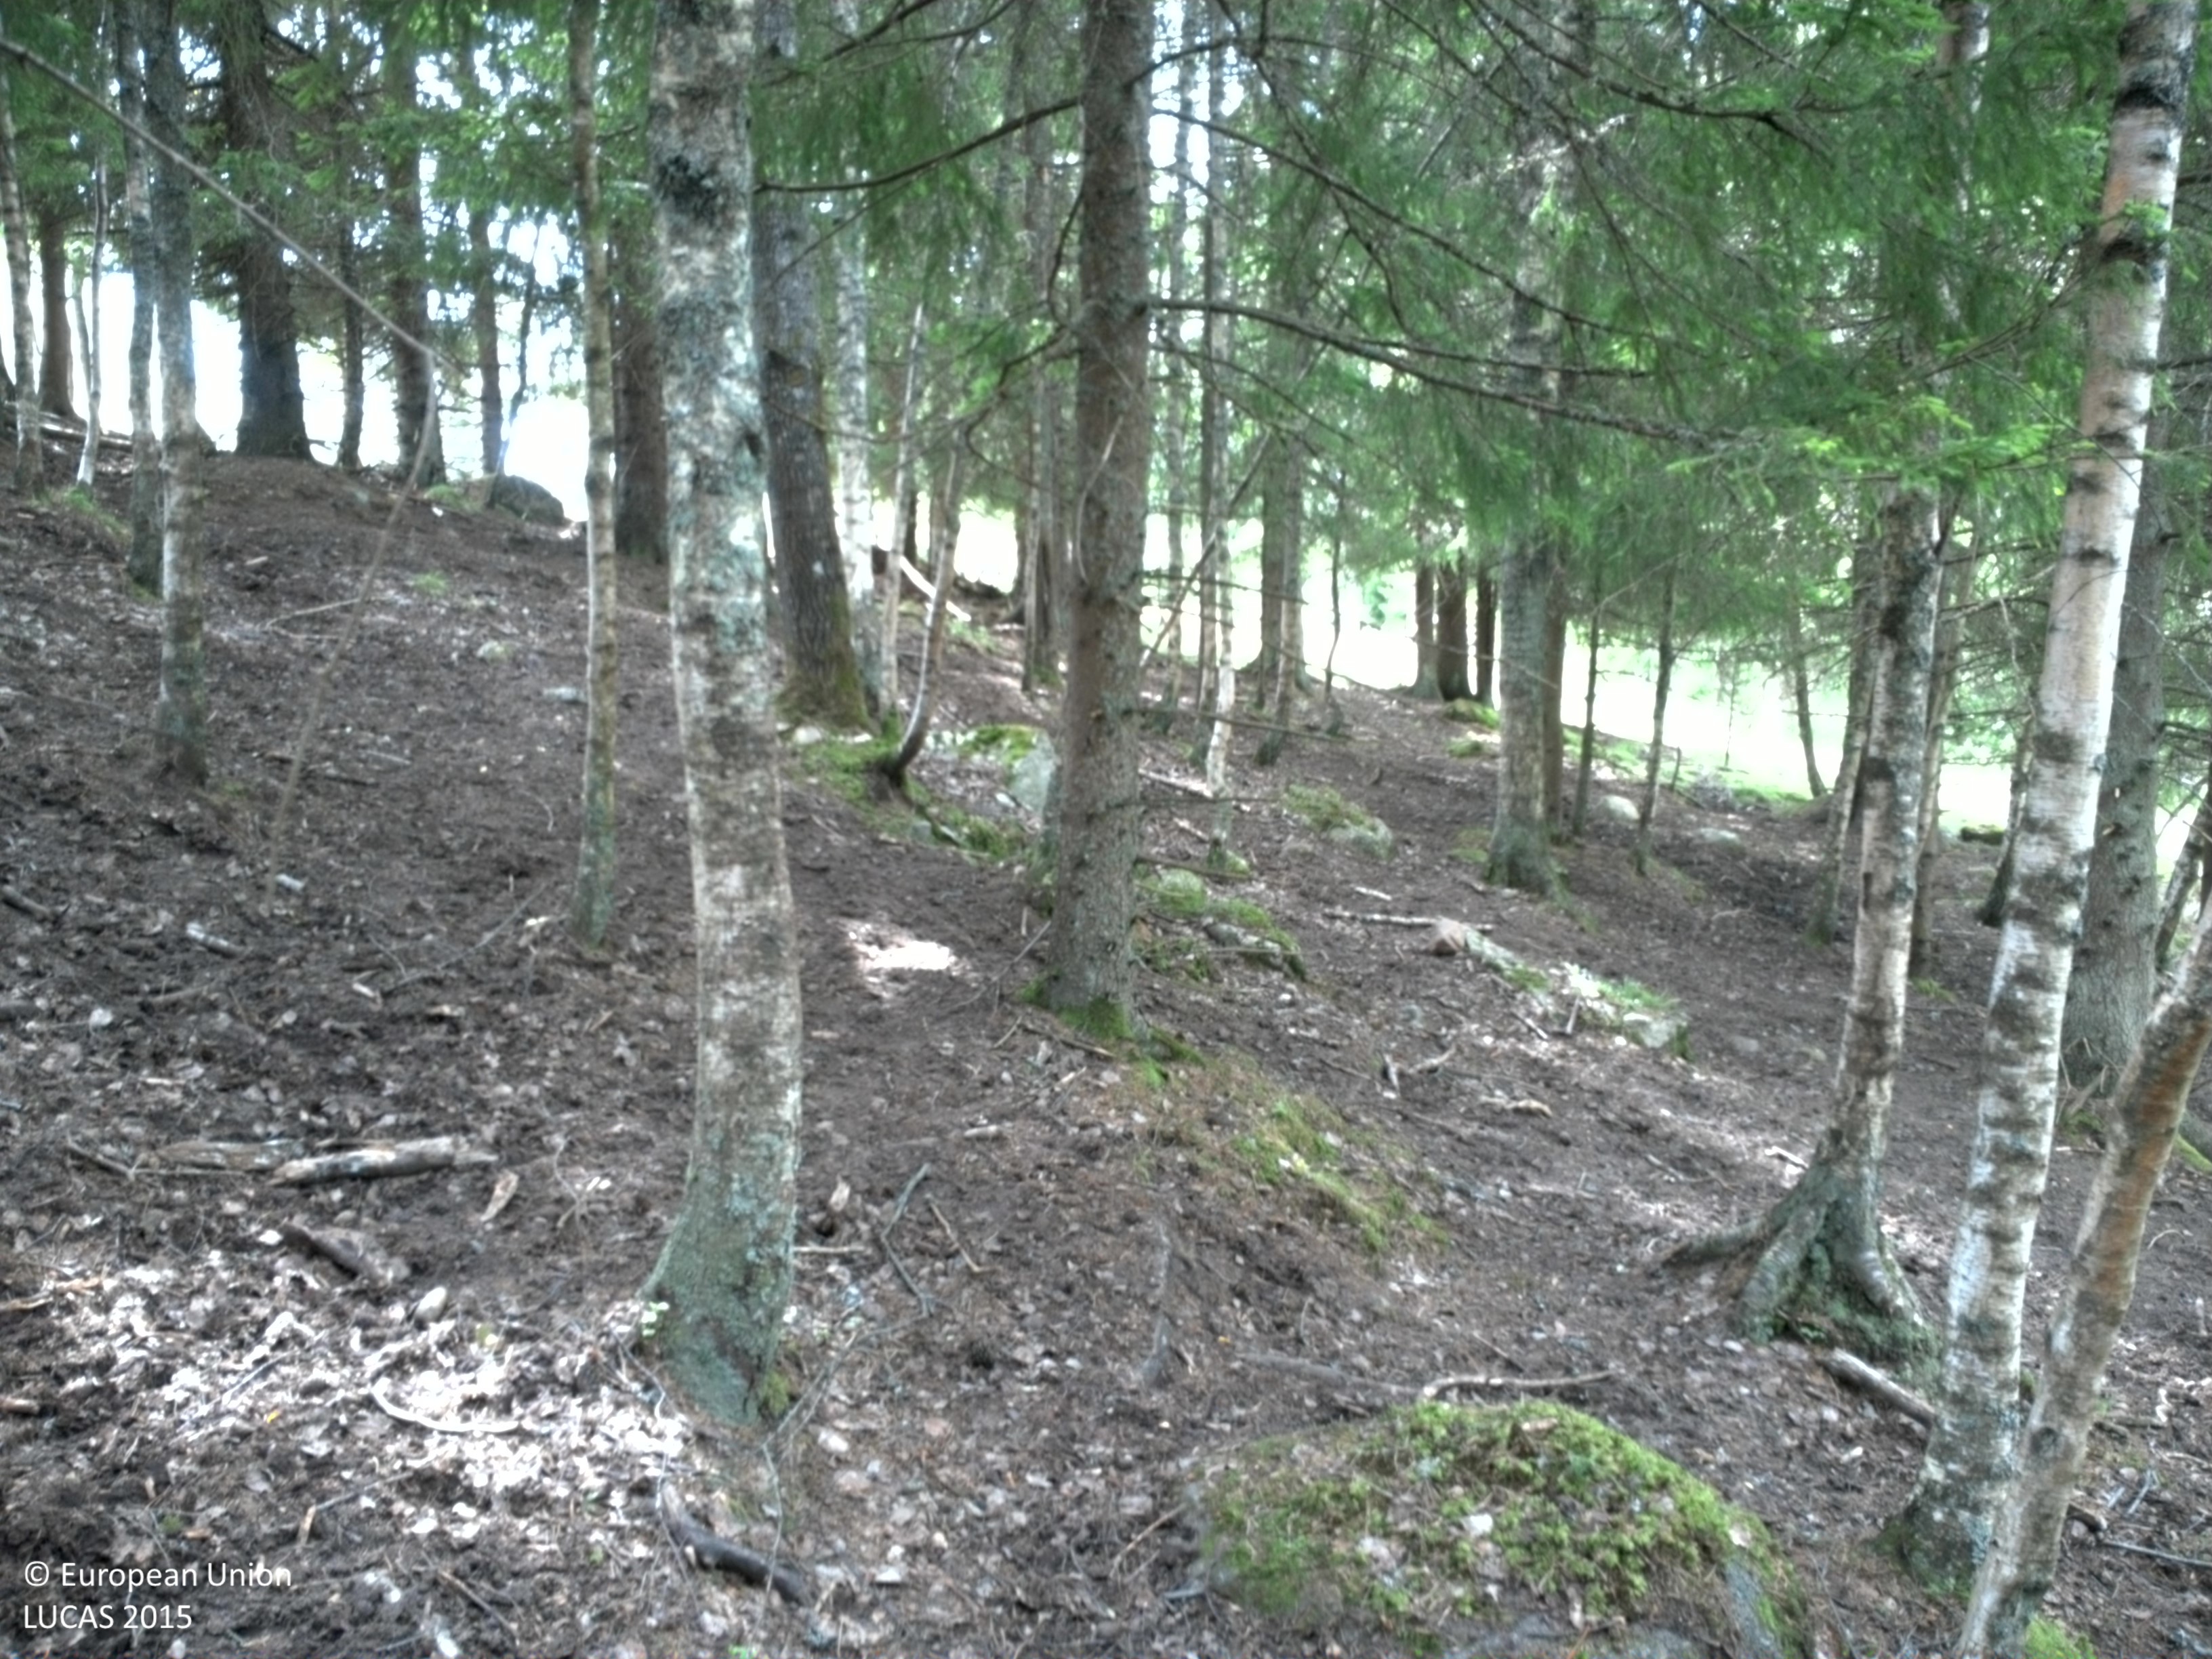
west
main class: Woodland
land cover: Spruce dominated coniferous woodland
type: boreal forest
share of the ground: > 75 %
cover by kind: coniferous forest trees 80 %, broadleaved forest trees 10 %, lichens and mosses 10 %
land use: Forestry
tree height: > 5 m
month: July
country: SE
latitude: 57.5419
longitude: 14.7236
